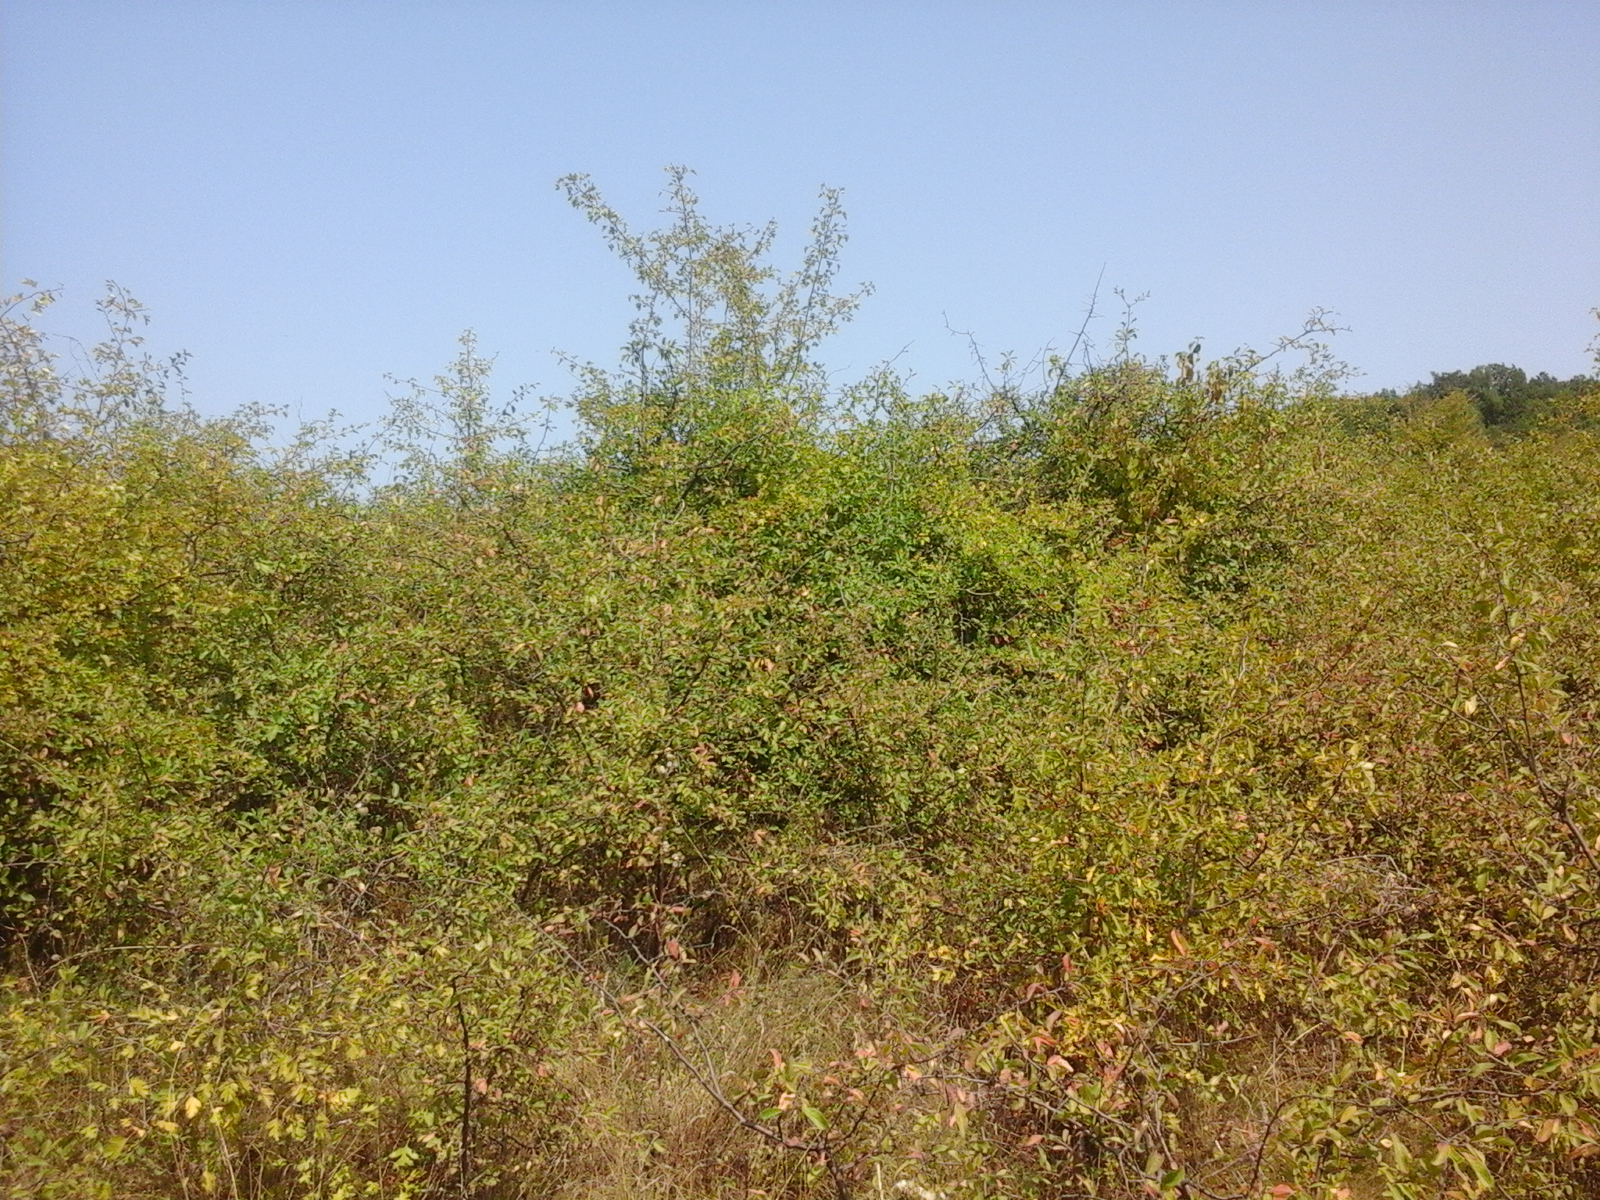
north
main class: Shrubland
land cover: Shrubland with sparse tree cover
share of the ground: > 75 %
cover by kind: shrubs 95 %, broadleaved forest trees 5 %
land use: Semi-natural and natural areas not in use
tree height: < 5 m
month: August
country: RO
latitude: 44.5452
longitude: 23.3299
